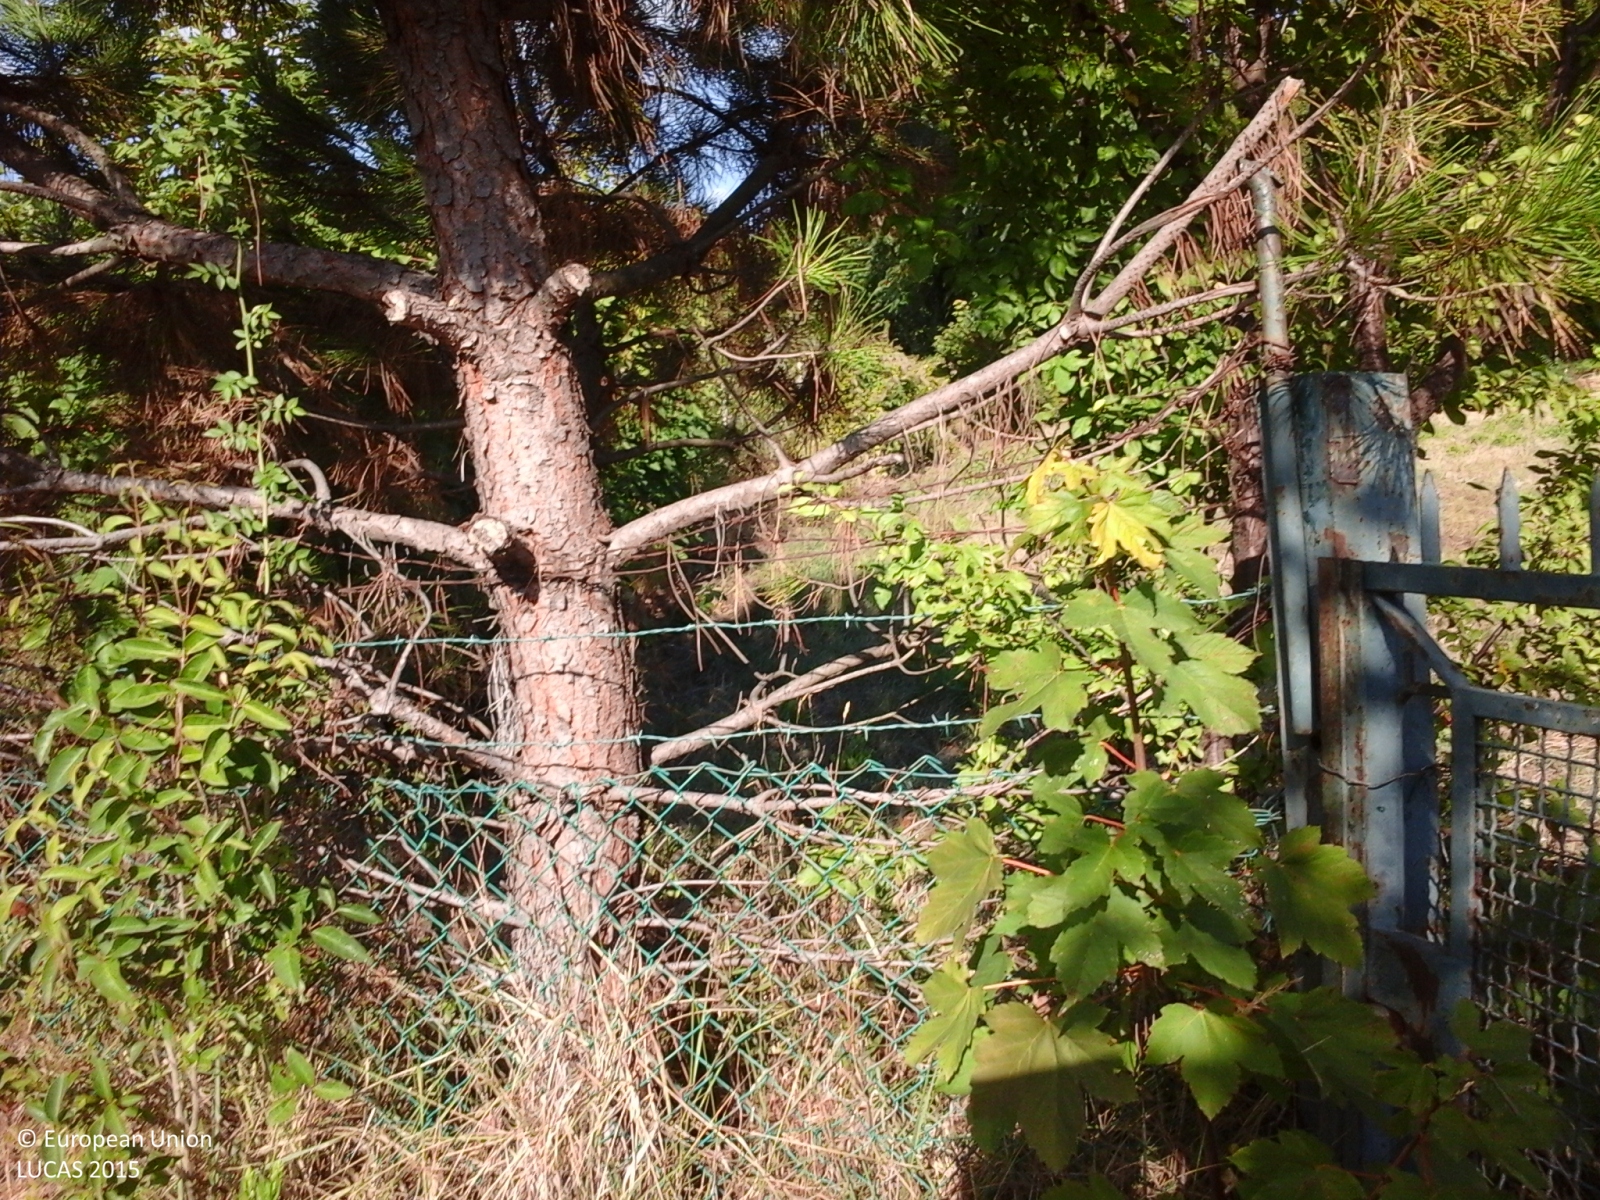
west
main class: Woodland
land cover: Broadleaved woodland
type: thermophilous deciduous forest
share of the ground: > 75 %
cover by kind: broadleaved forest trees 100 %
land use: Forestry
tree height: > 5 m
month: September
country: IT
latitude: 43.8937
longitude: 12.9436
